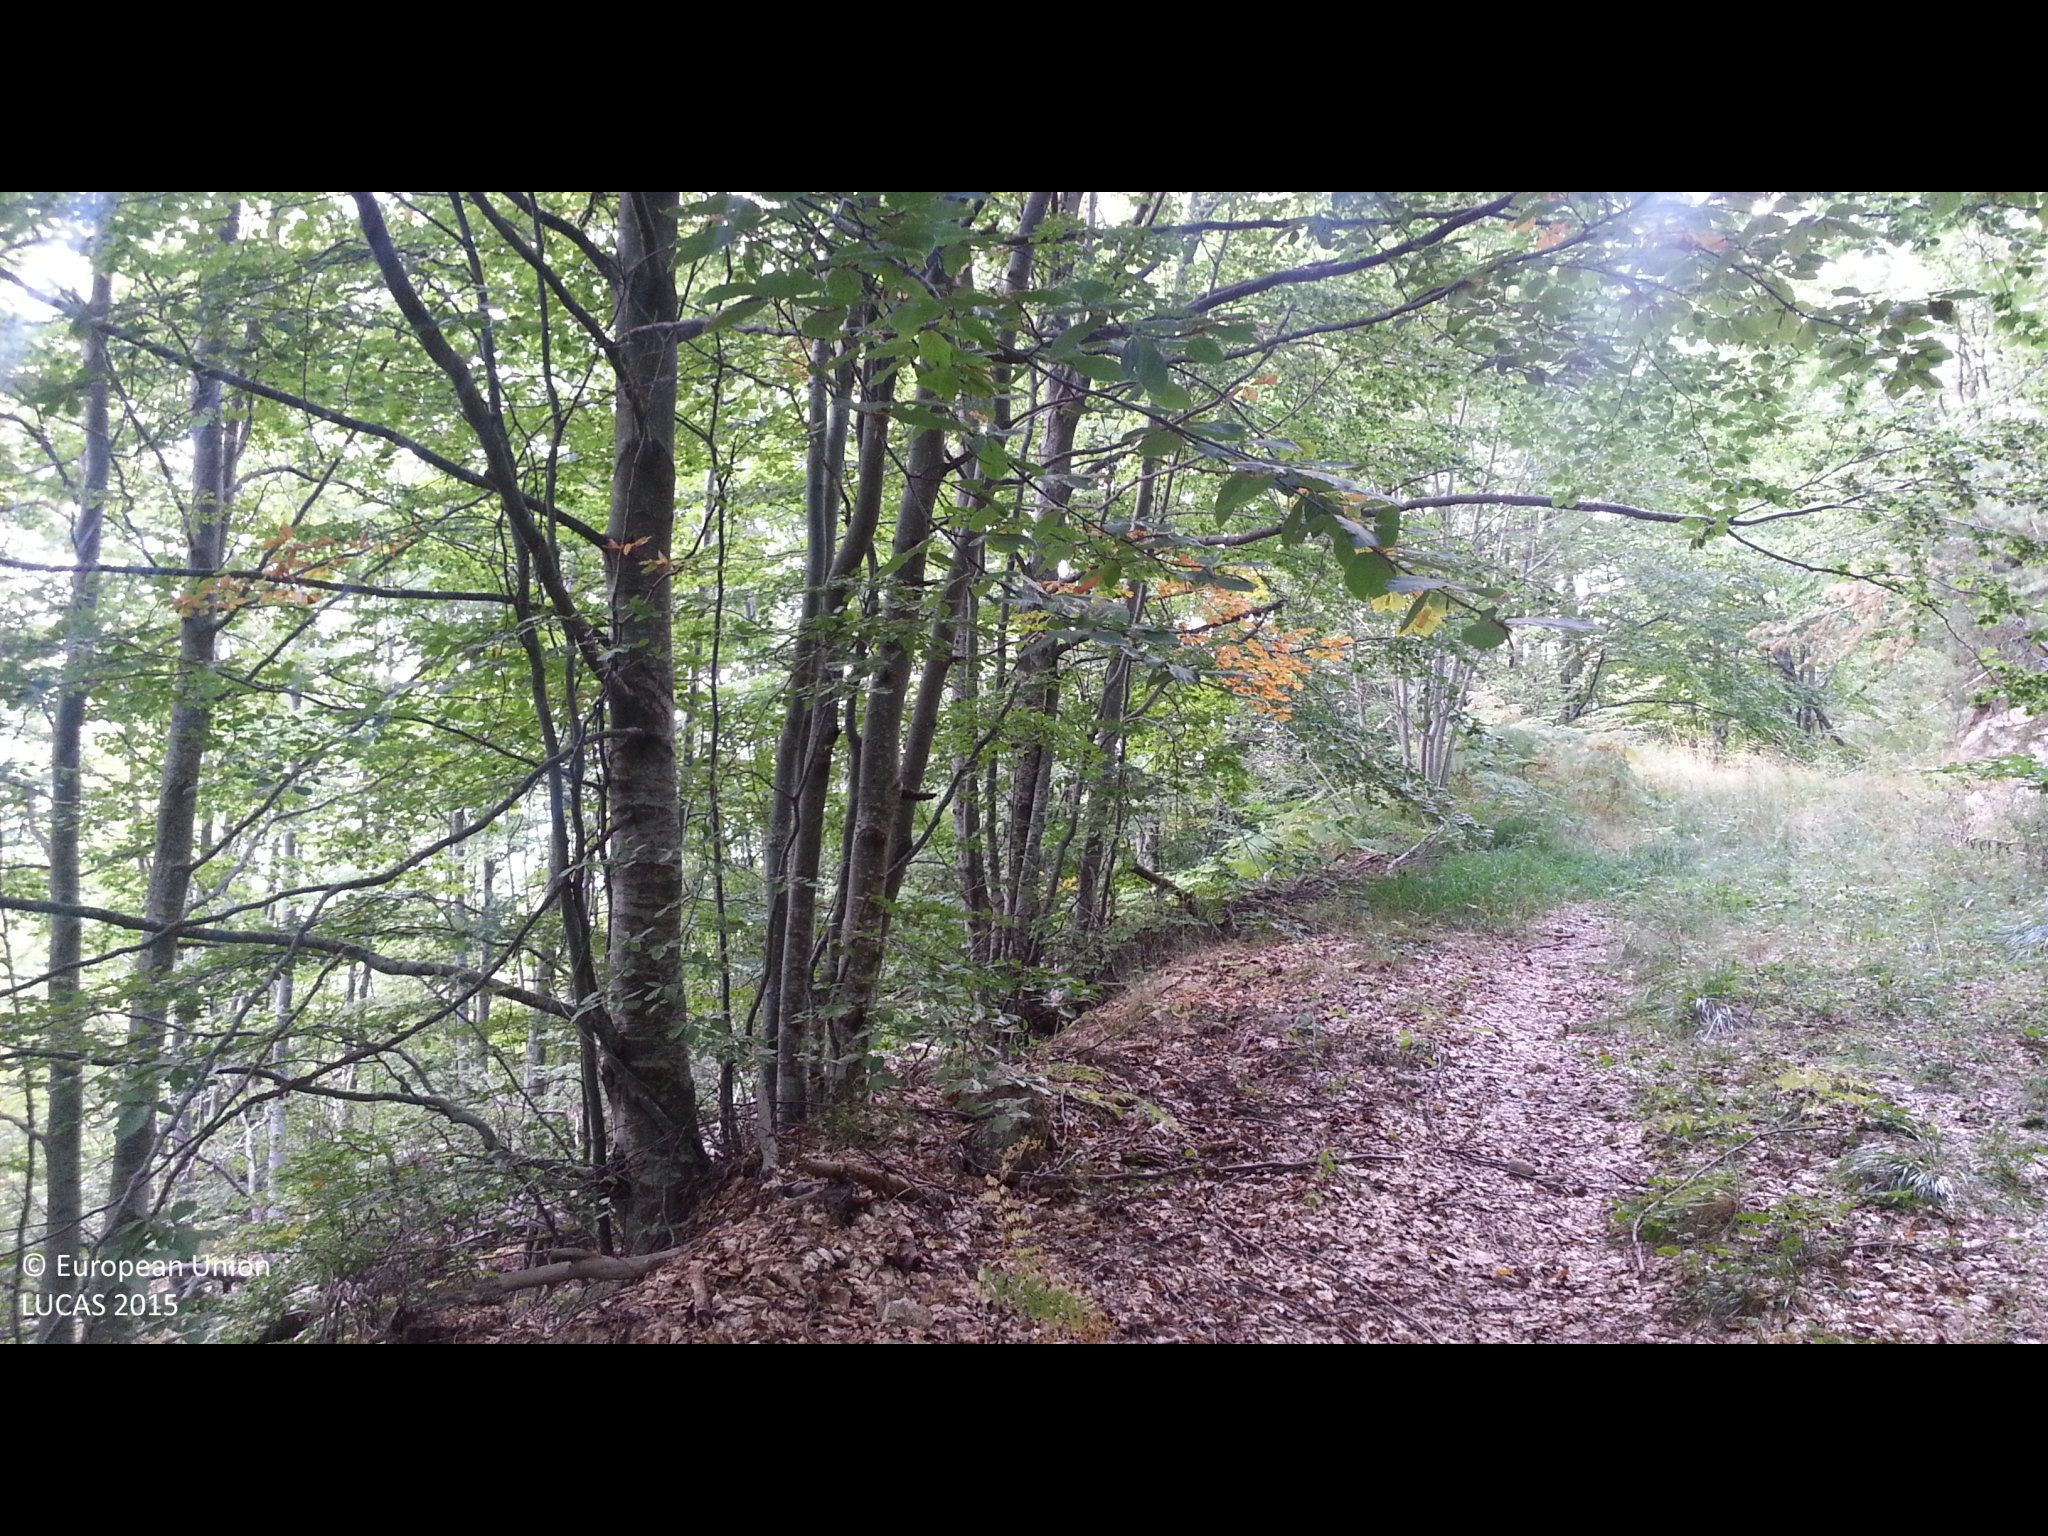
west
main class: Woodland
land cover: Broadleaved woodland
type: mesophytic deciduous forest
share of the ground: > 75 %
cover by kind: broadleaved forest trees 95 %, shrubs 5 %
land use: Forestry
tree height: > 5 m
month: September
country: BG
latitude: 42.1536
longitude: 22.6177
